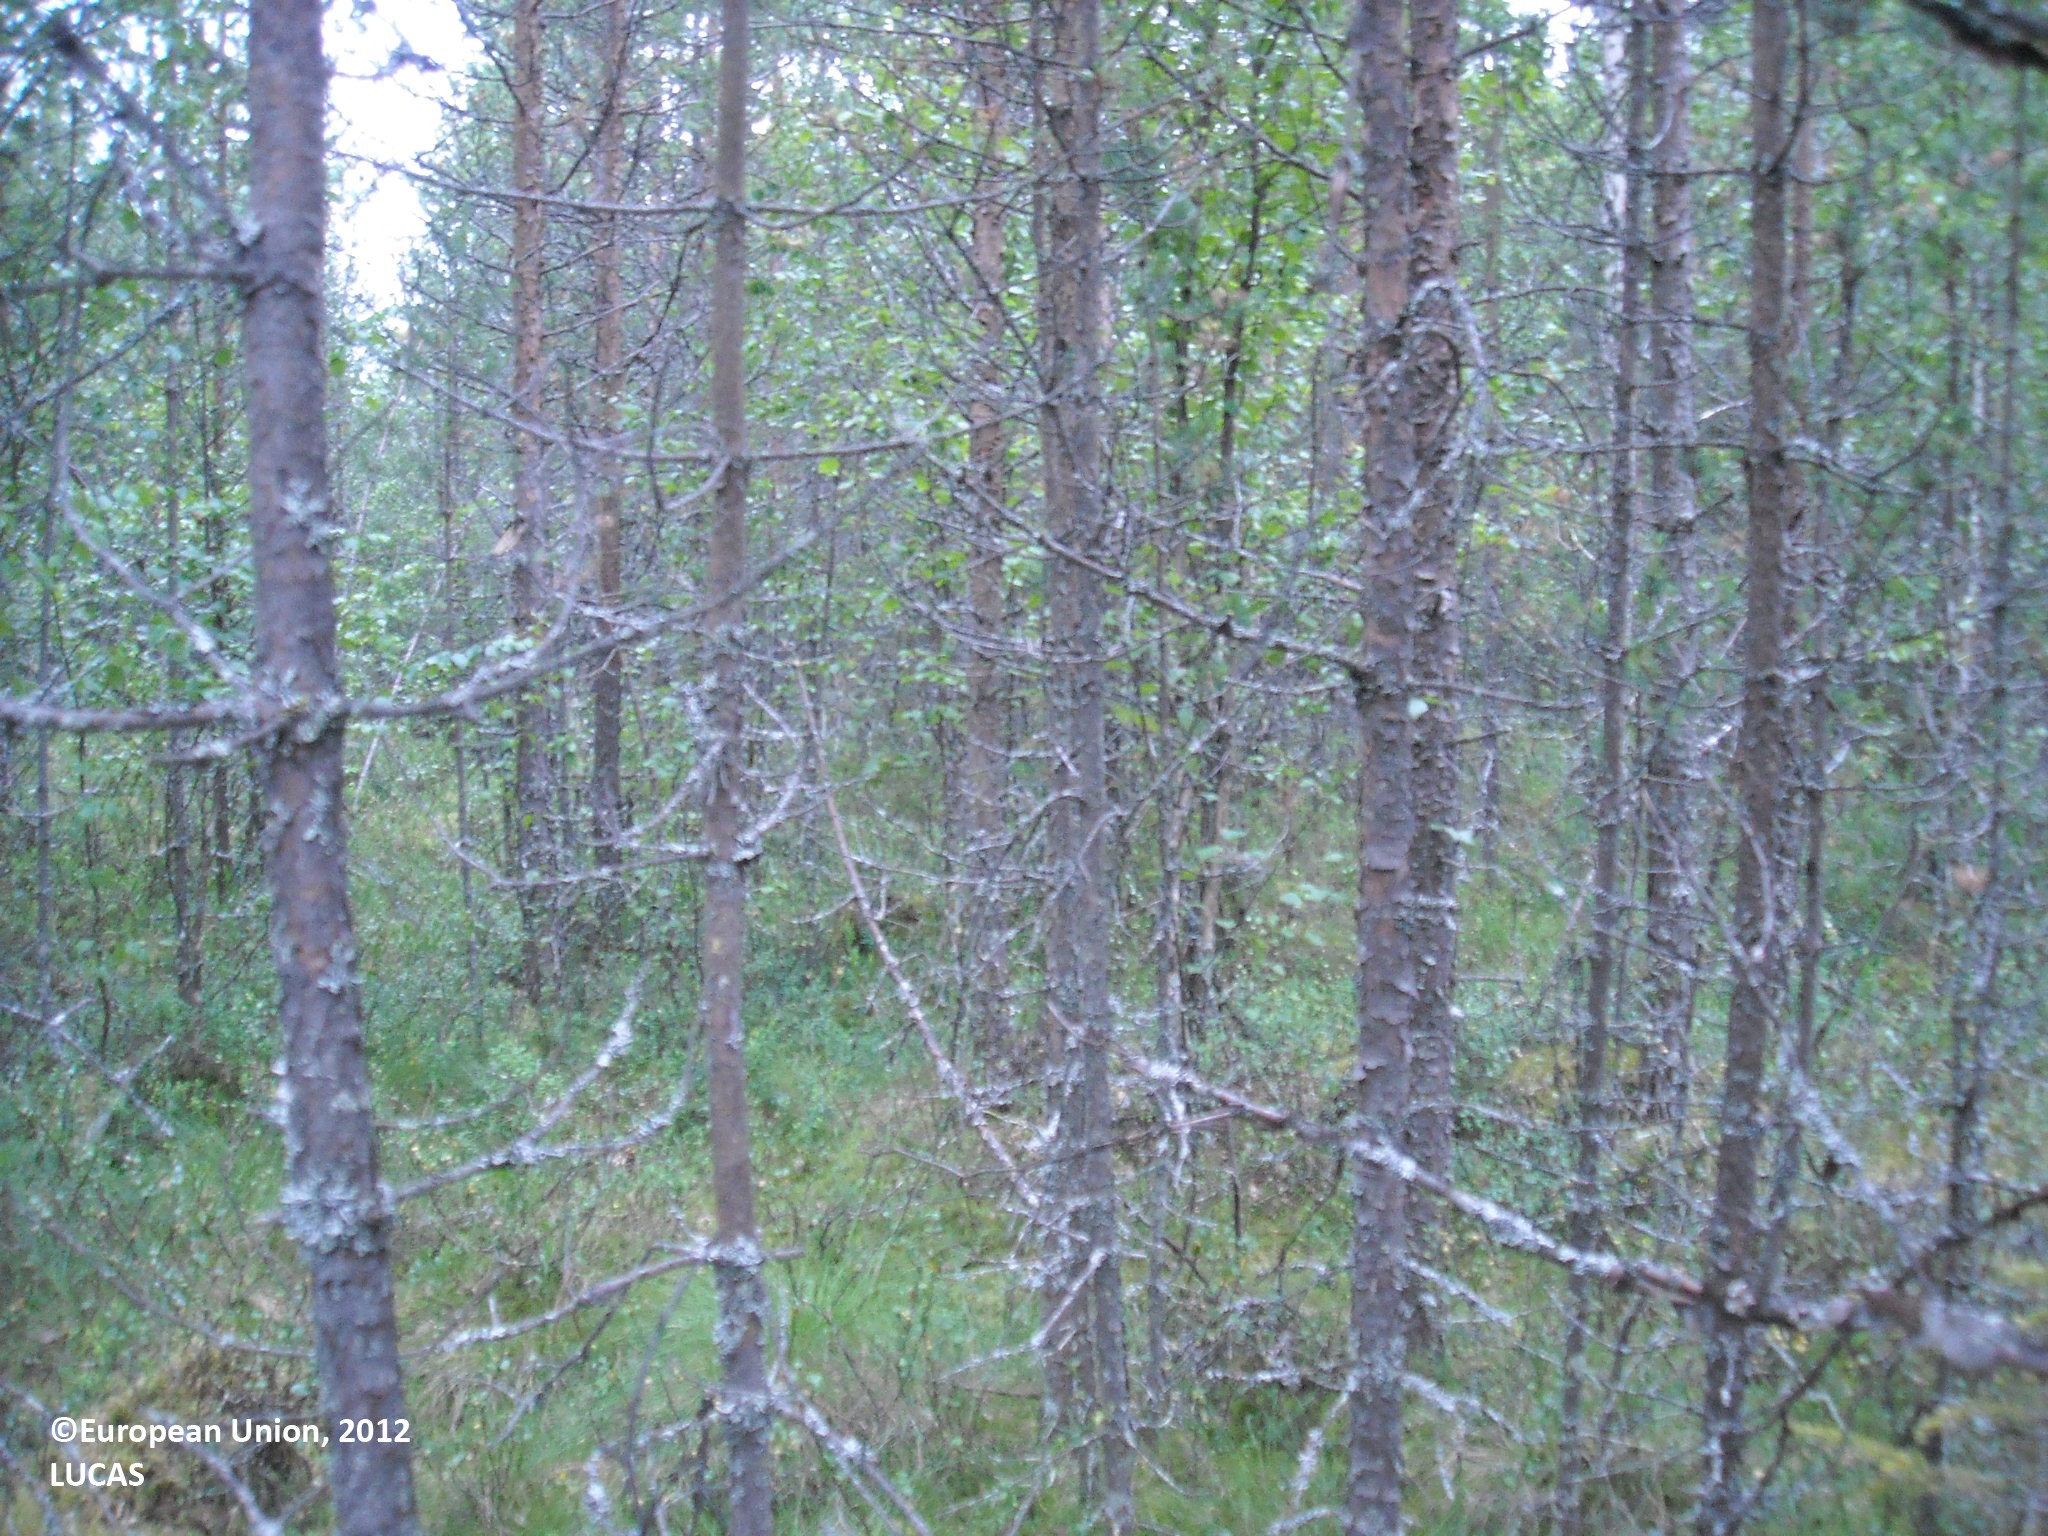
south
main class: Woodland
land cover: Pine dominated mixed woodland
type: mire and swamp forests
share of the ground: > 75 %
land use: Forestry
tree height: > 5 m
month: July
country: FI
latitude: 64.9179
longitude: 26.8415
